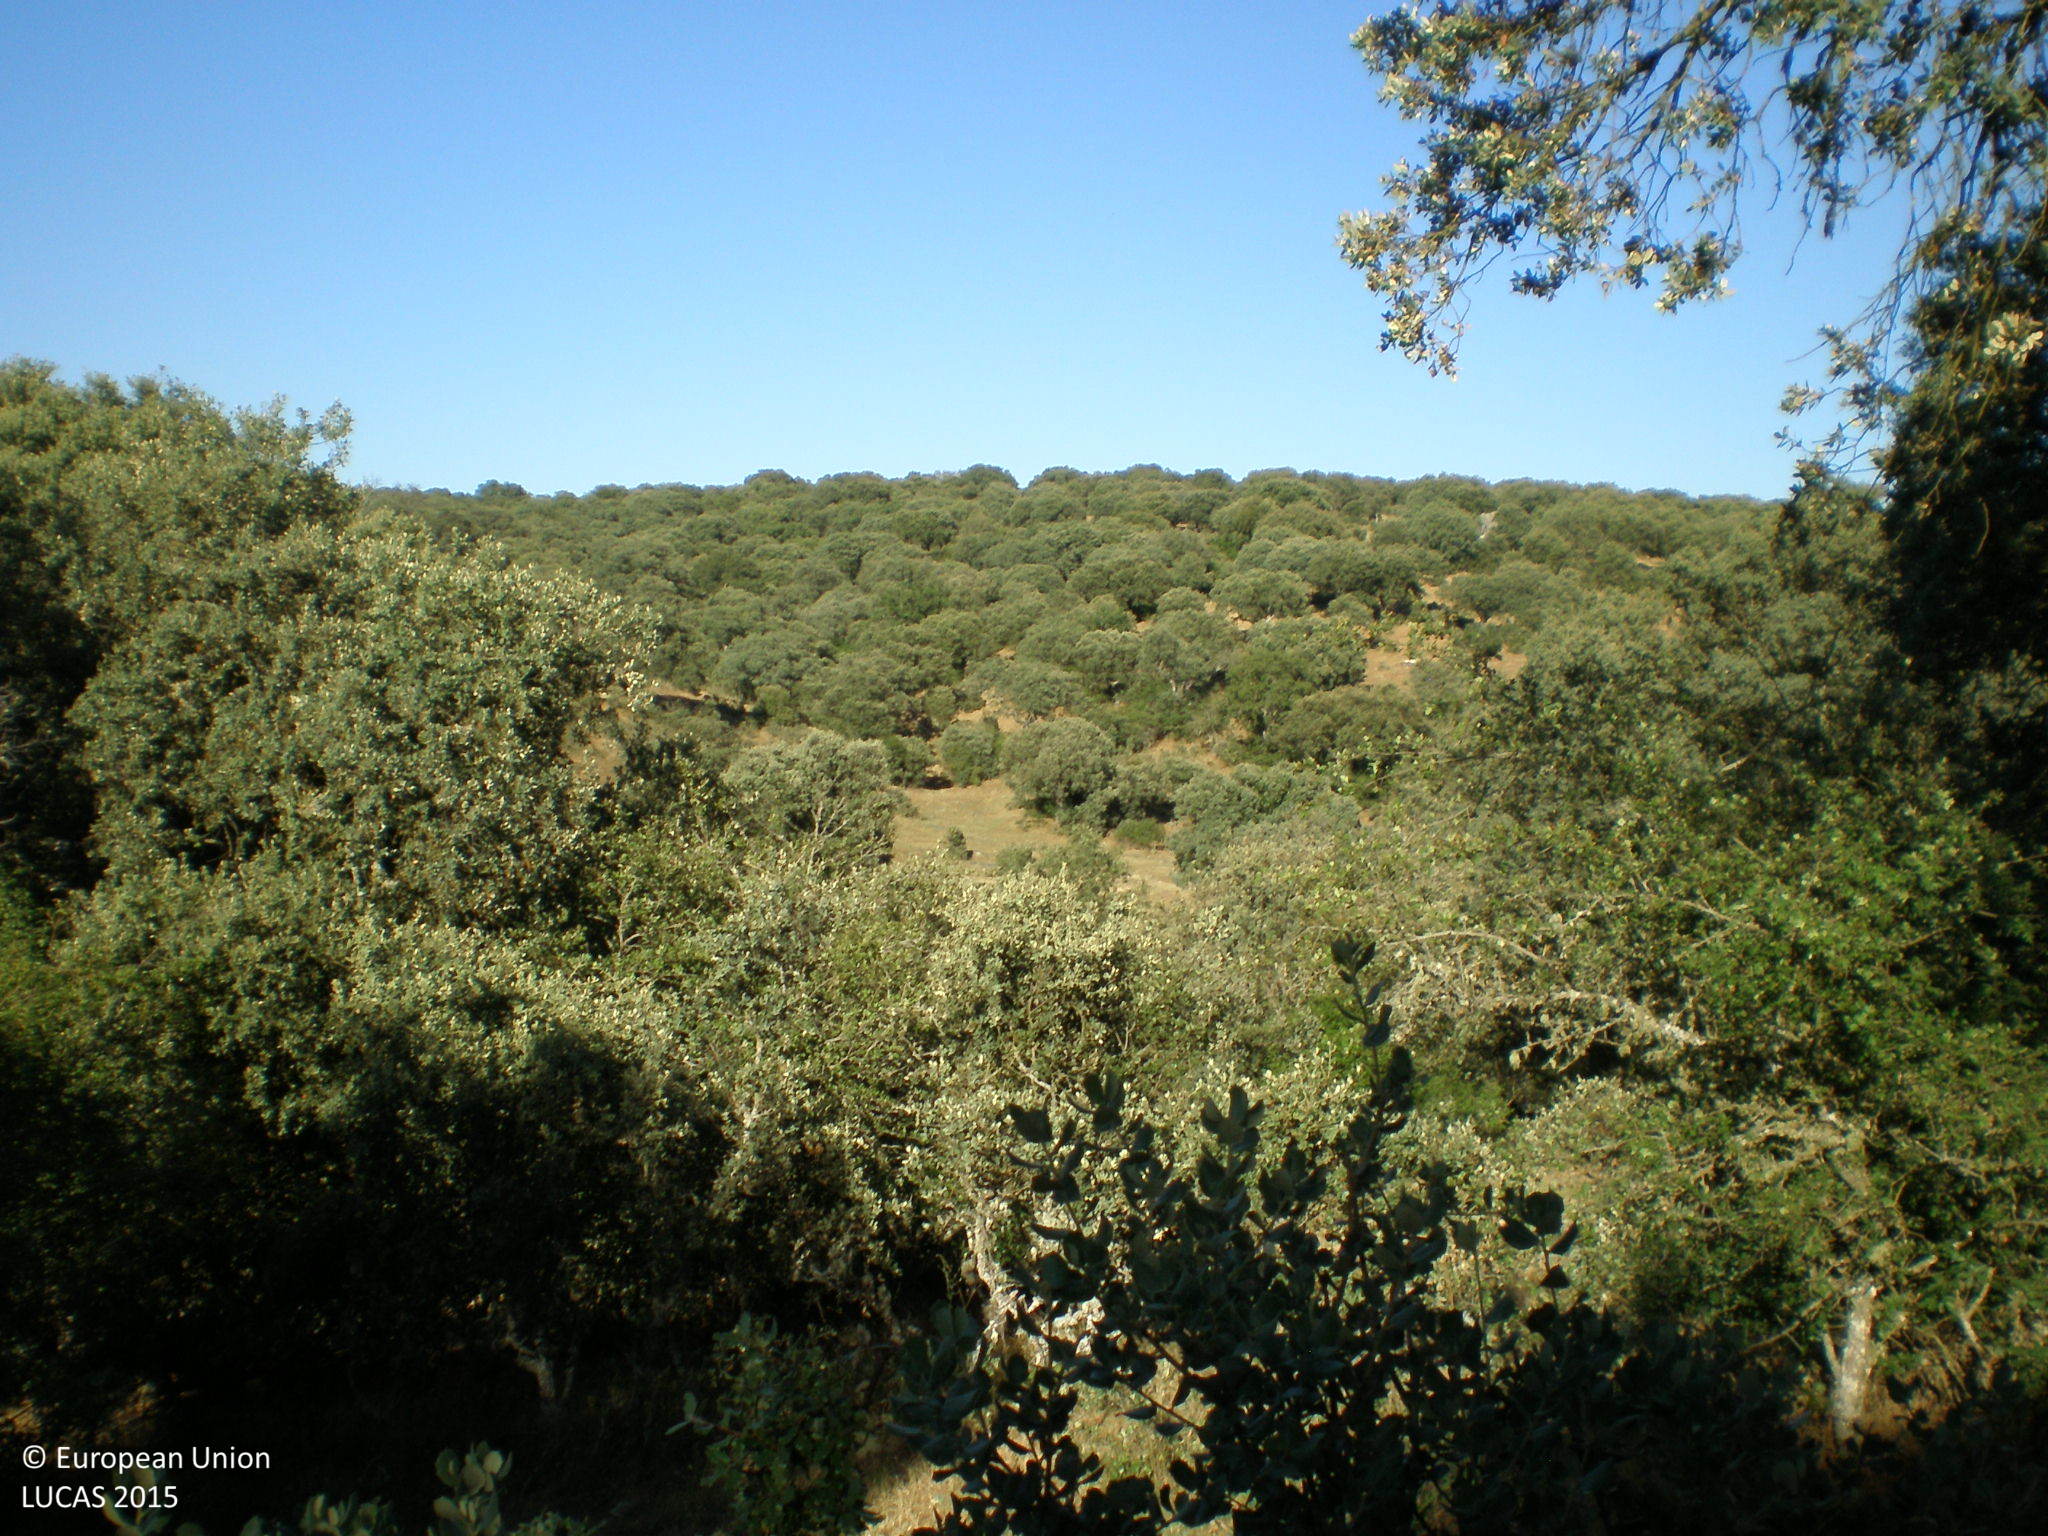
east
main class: Woodland
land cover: Broadleaved woodland
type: broadleaved evergreen forest
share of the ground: 50 - 75 %
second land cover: Grassland without tree/shrub cover
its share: 25 - 50 %
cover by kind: broadleaved forest trees 55 %, herbaceous plants 45 %
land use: Forestry
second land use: Agriculture (excluding fallow land and kitchen gardens)
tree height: > 5 m
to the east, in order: Broadleaved woodland; Grassland without tree/shrub cover; Inland fresh running water; Broadleaved woodland
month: June
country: ES
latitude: 40.7456
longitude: -5.6715
